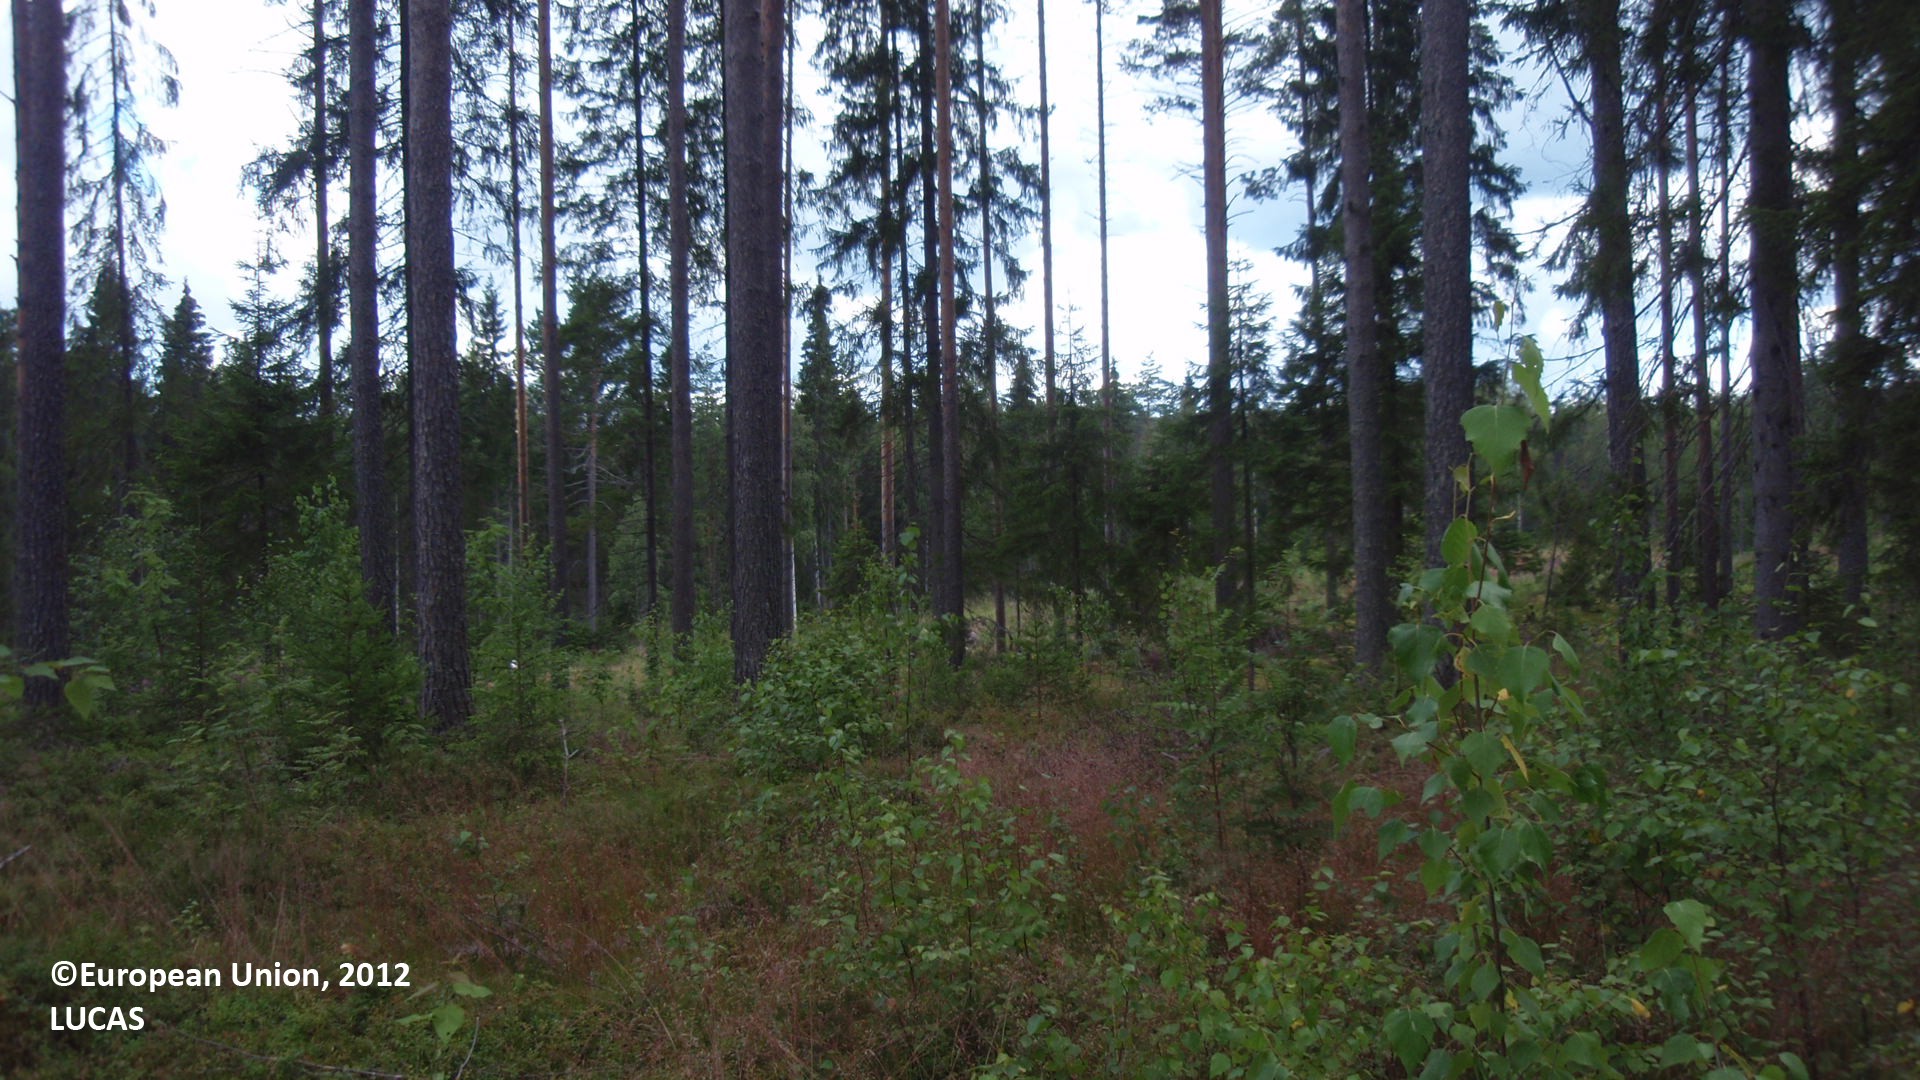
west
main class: Woodland
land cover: Pine dominated mixed woodland
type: boreal forest
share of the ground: 25 - 50 %
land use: Forestry
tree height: > 5 m
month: July
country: FI
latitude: 61.4217
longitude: 28.9895
